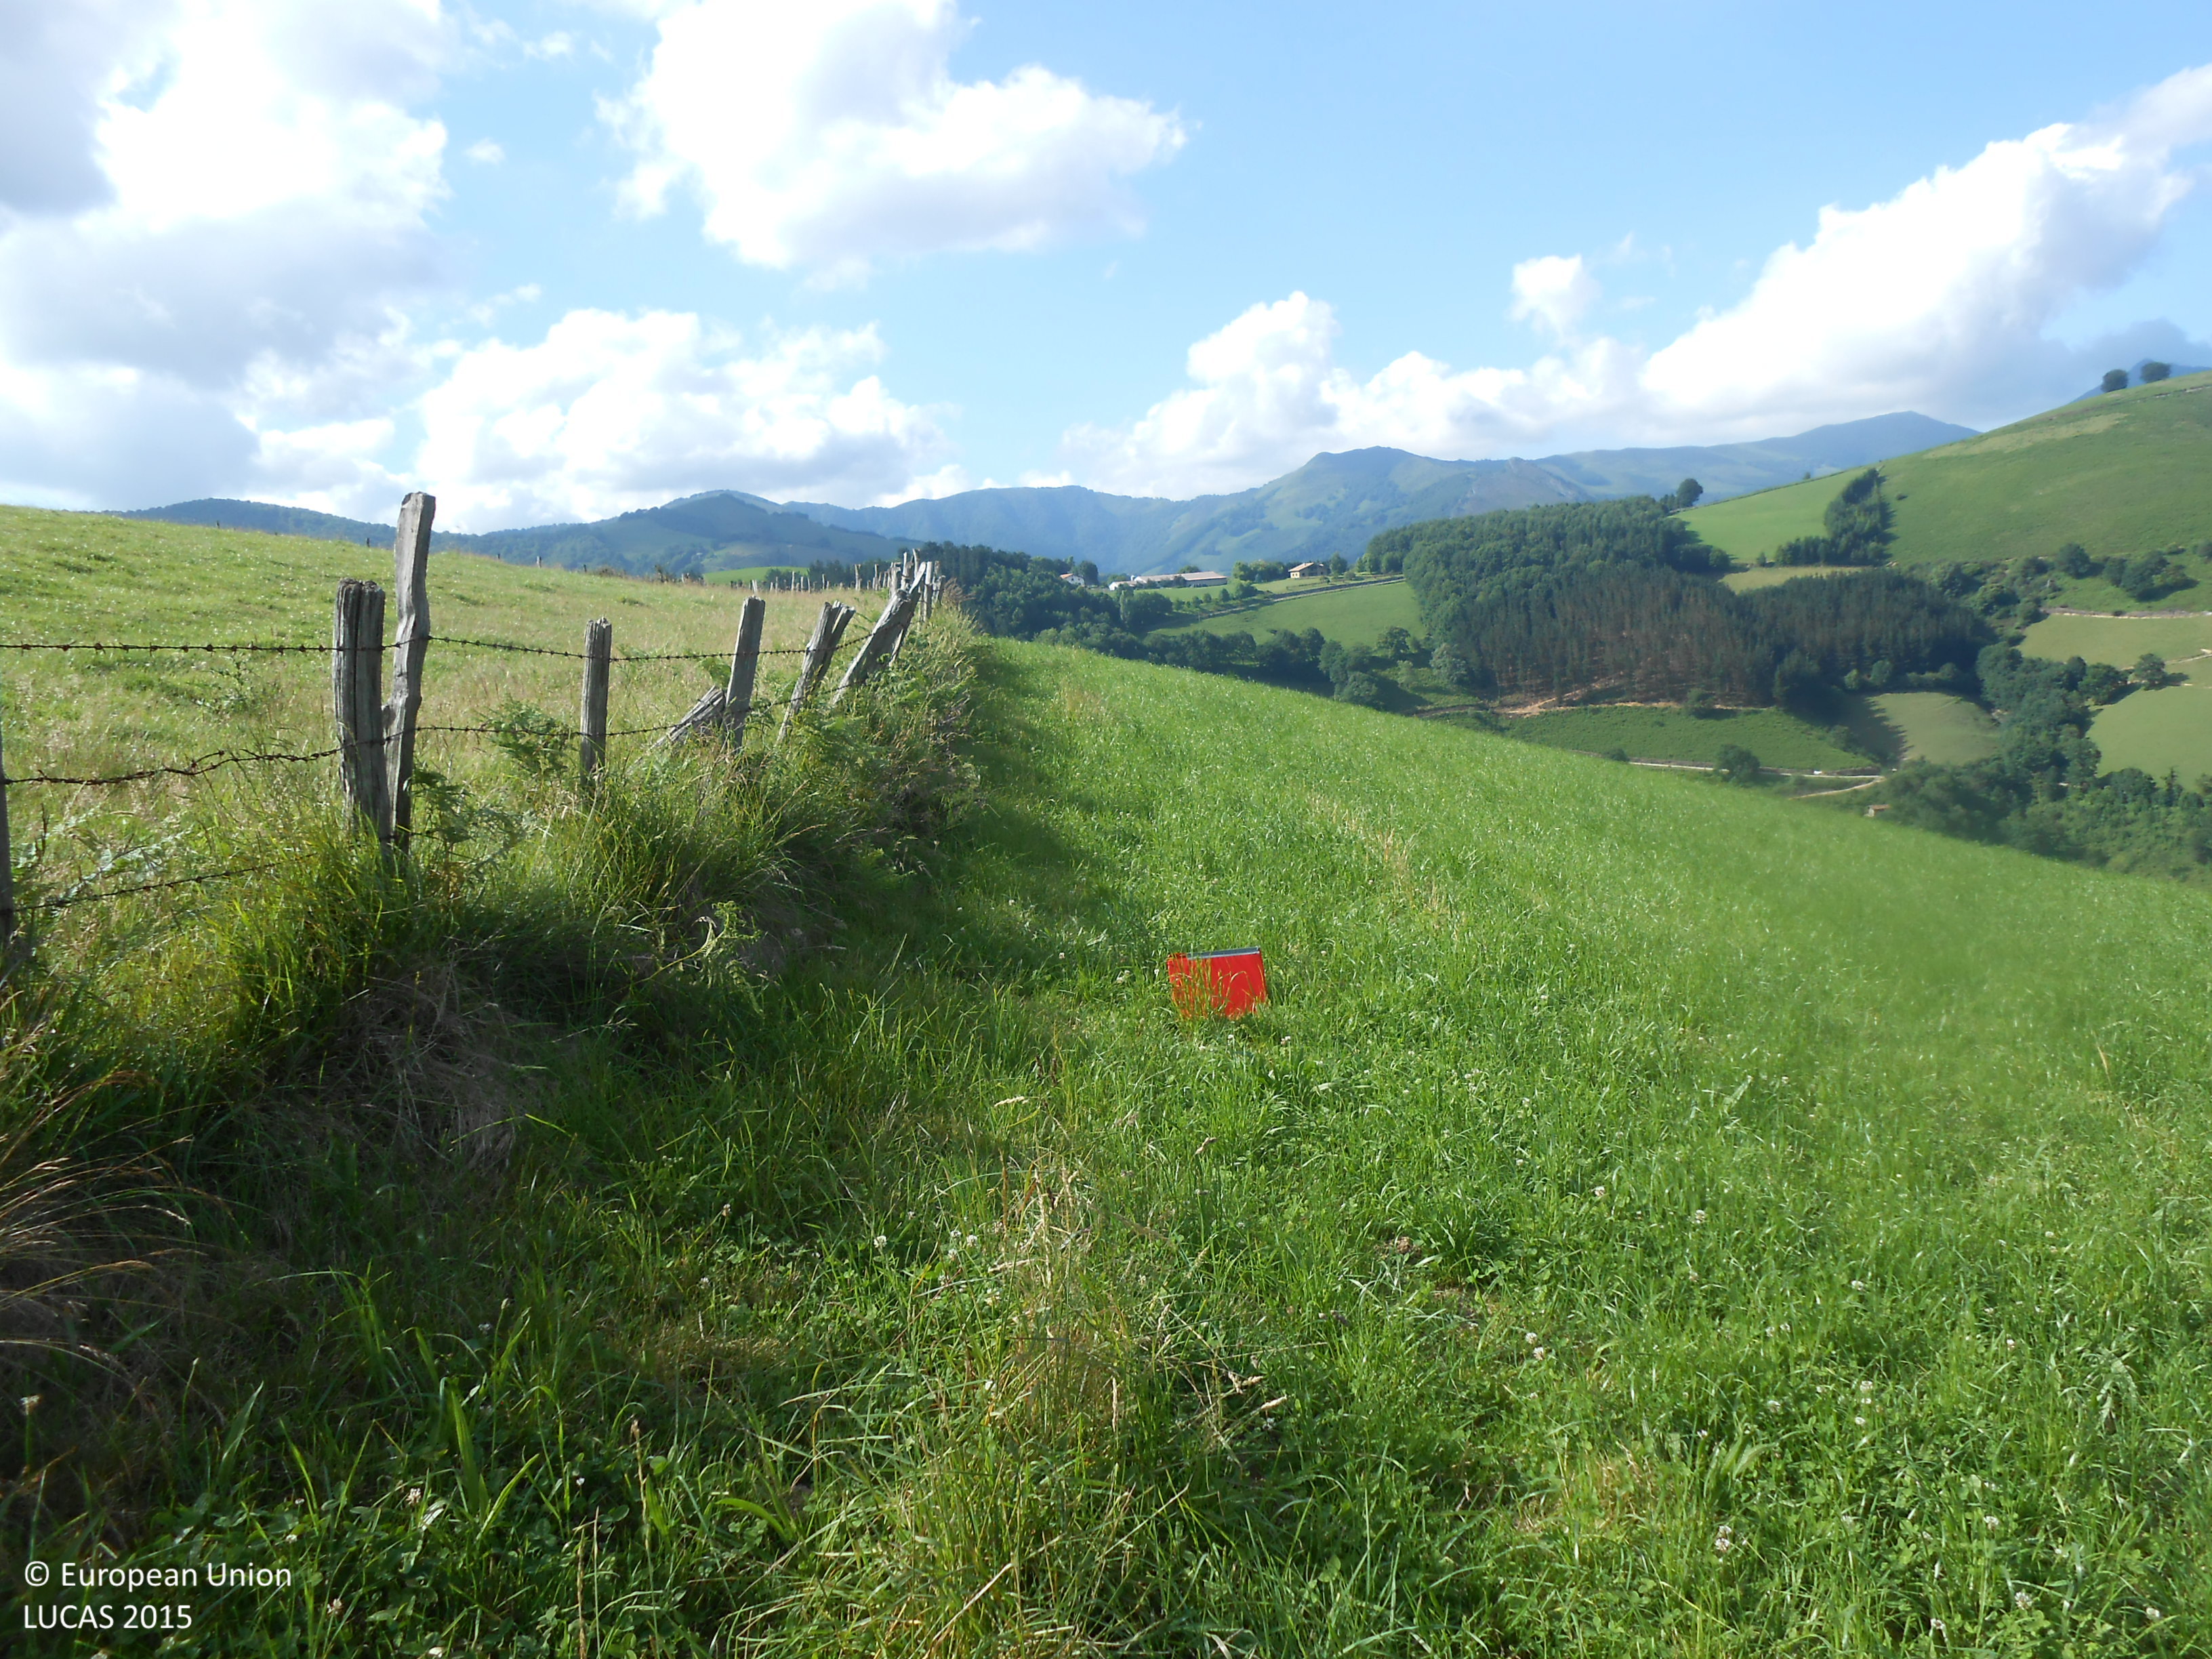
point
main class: Grassland
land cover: Grassland without tree/shrub cover
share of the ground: > 75 %
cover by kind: herbaceous plants 100 %
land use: Agriculture (excluding fallow land and kitchen gardens)
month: June
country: ES
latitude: 43.0975
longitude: -1.7514
